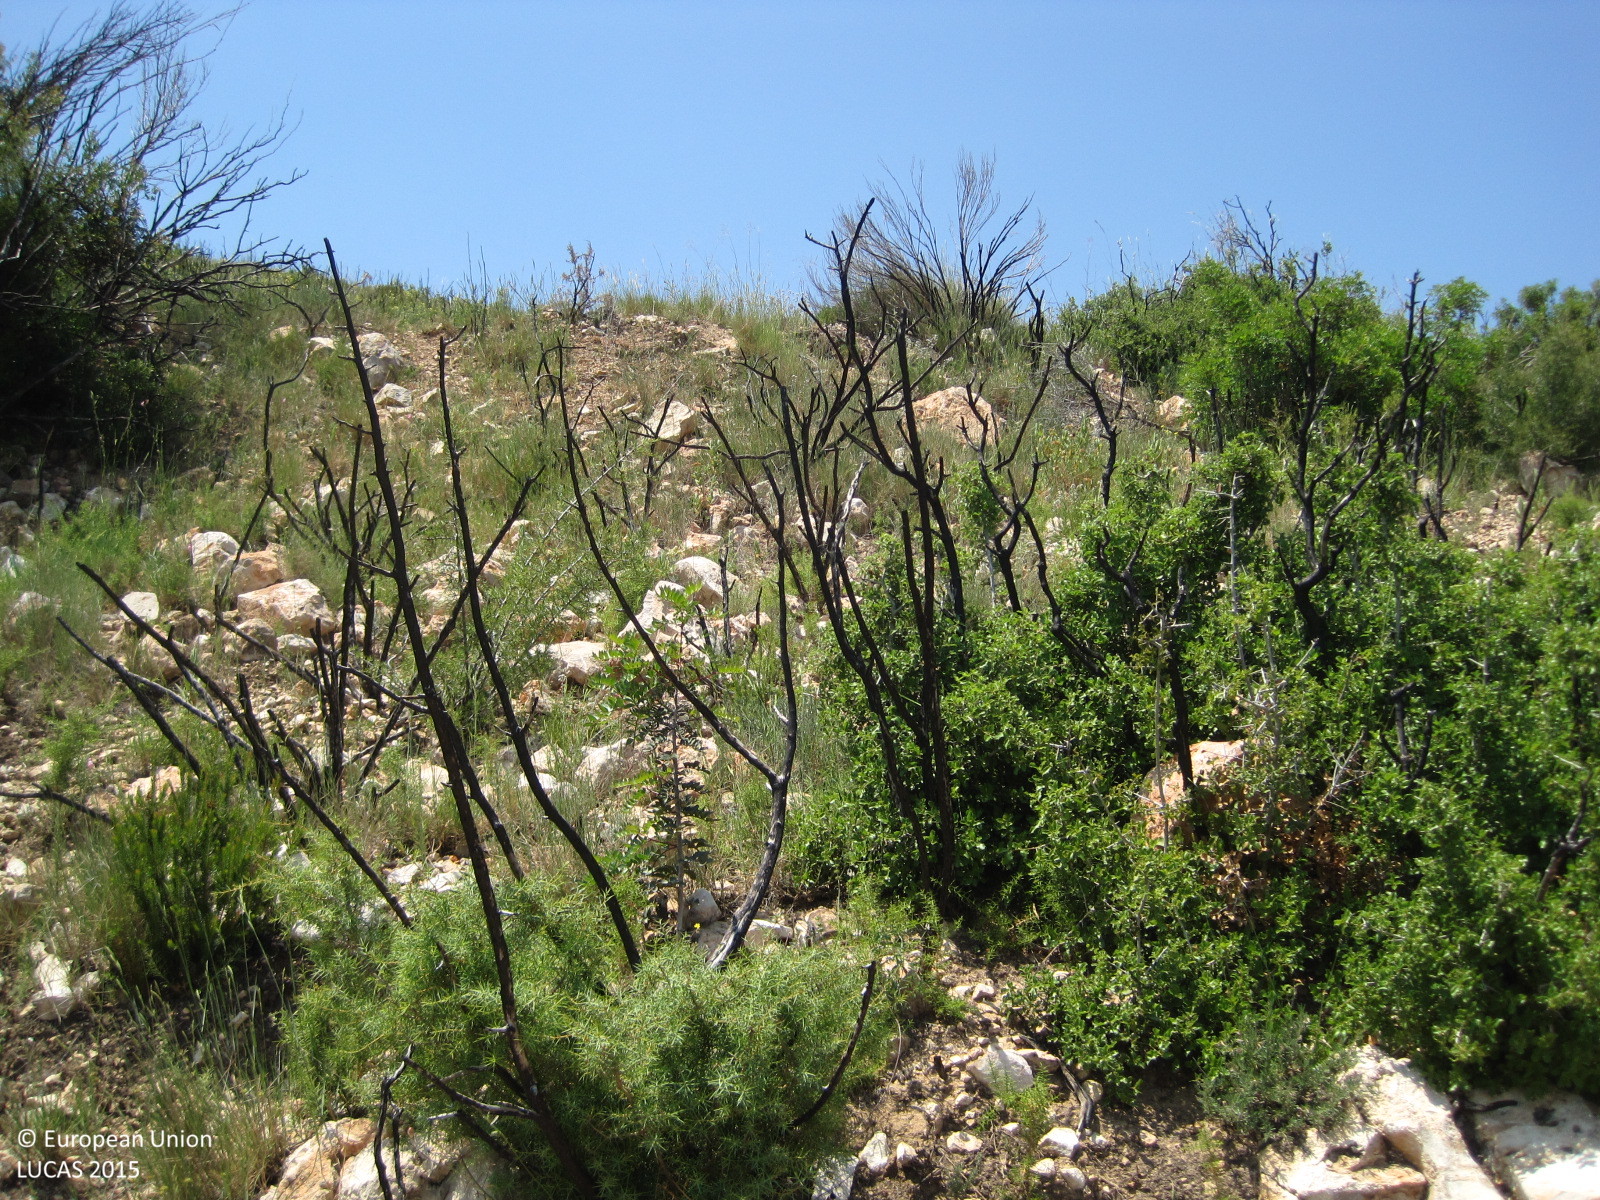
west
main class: Shrubland
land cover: Shrubland without tree cover
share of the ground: 50 - 75 %
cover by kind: shrubs 50 %, consolidated bare surface 35 %, herbaceous plants 15 %
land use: Semi-natural and natural areas not in use
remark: Burnt area
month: June
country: ES
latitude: 39.2642
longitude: -0.8338
